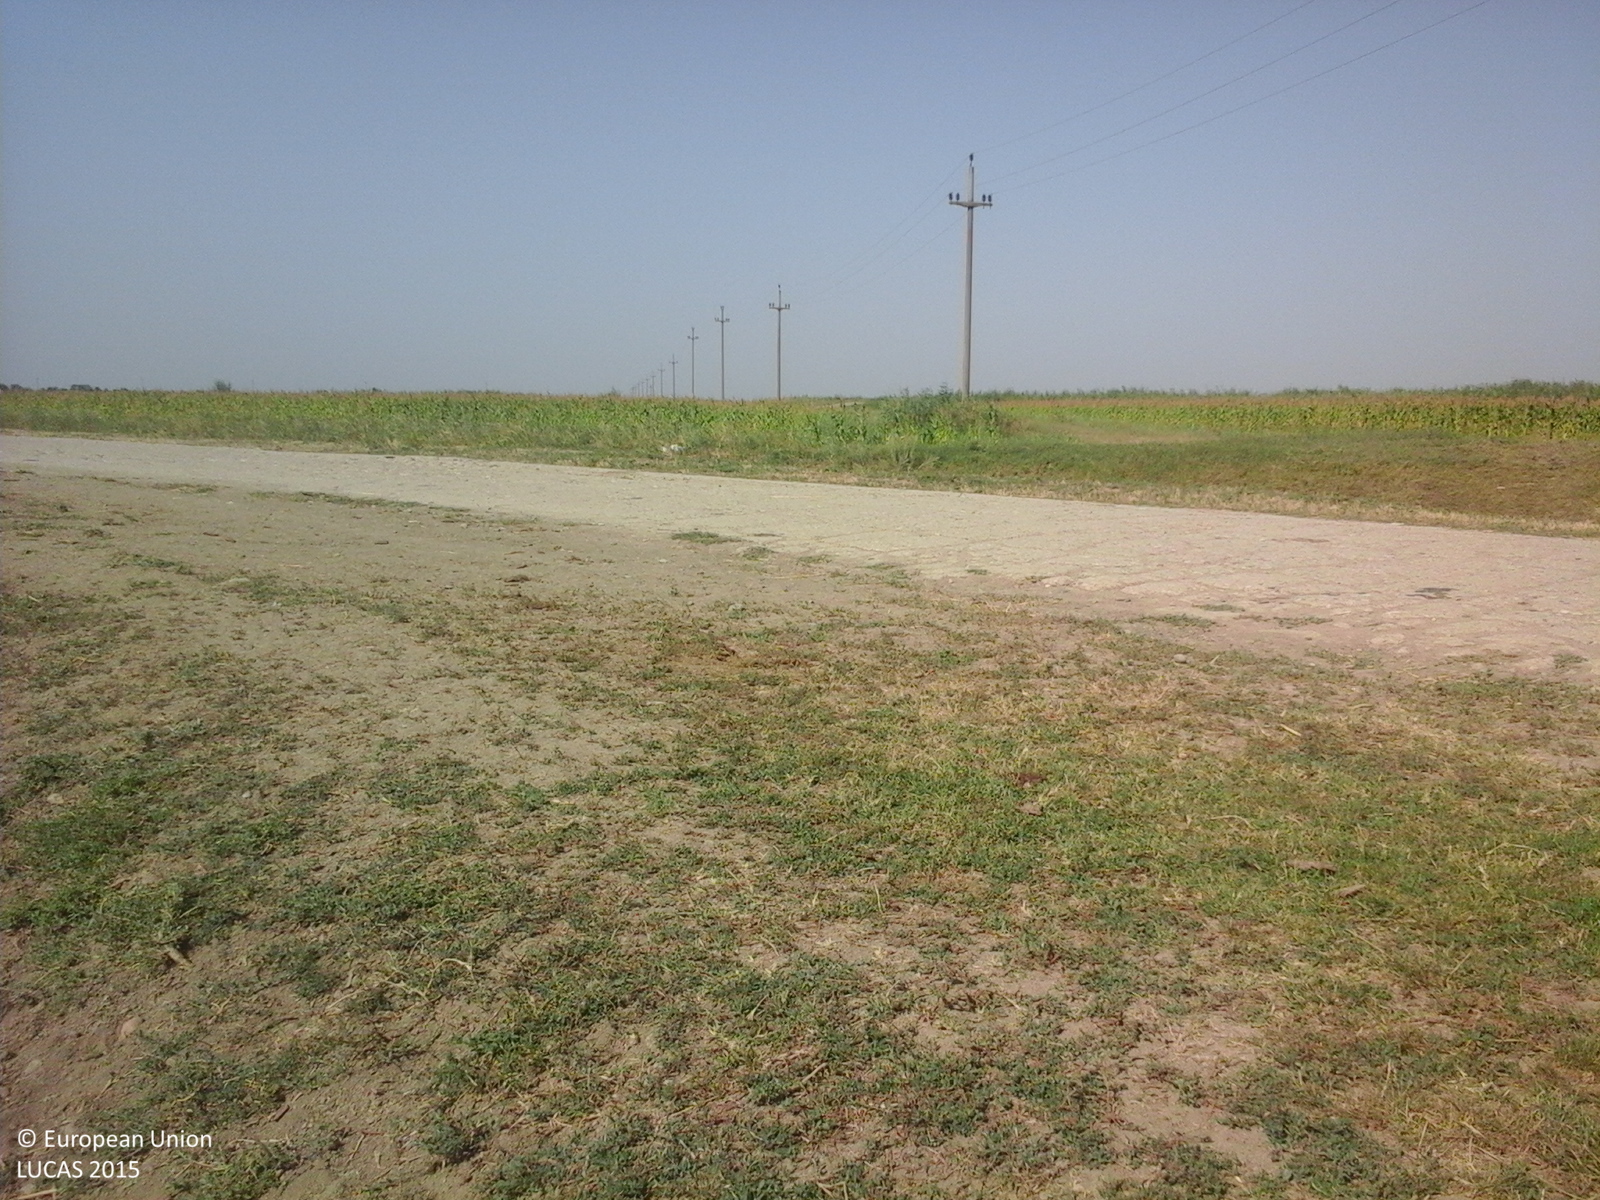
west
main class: Grassland
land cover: Grassland without tree/shrub cover
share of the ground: > 75 %
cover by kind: herbaceous plants 100 %
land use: Agriculture (excluding fallow land and kitchen gardens)
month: August
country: RO
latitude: 45.3644
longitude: 27.7659
